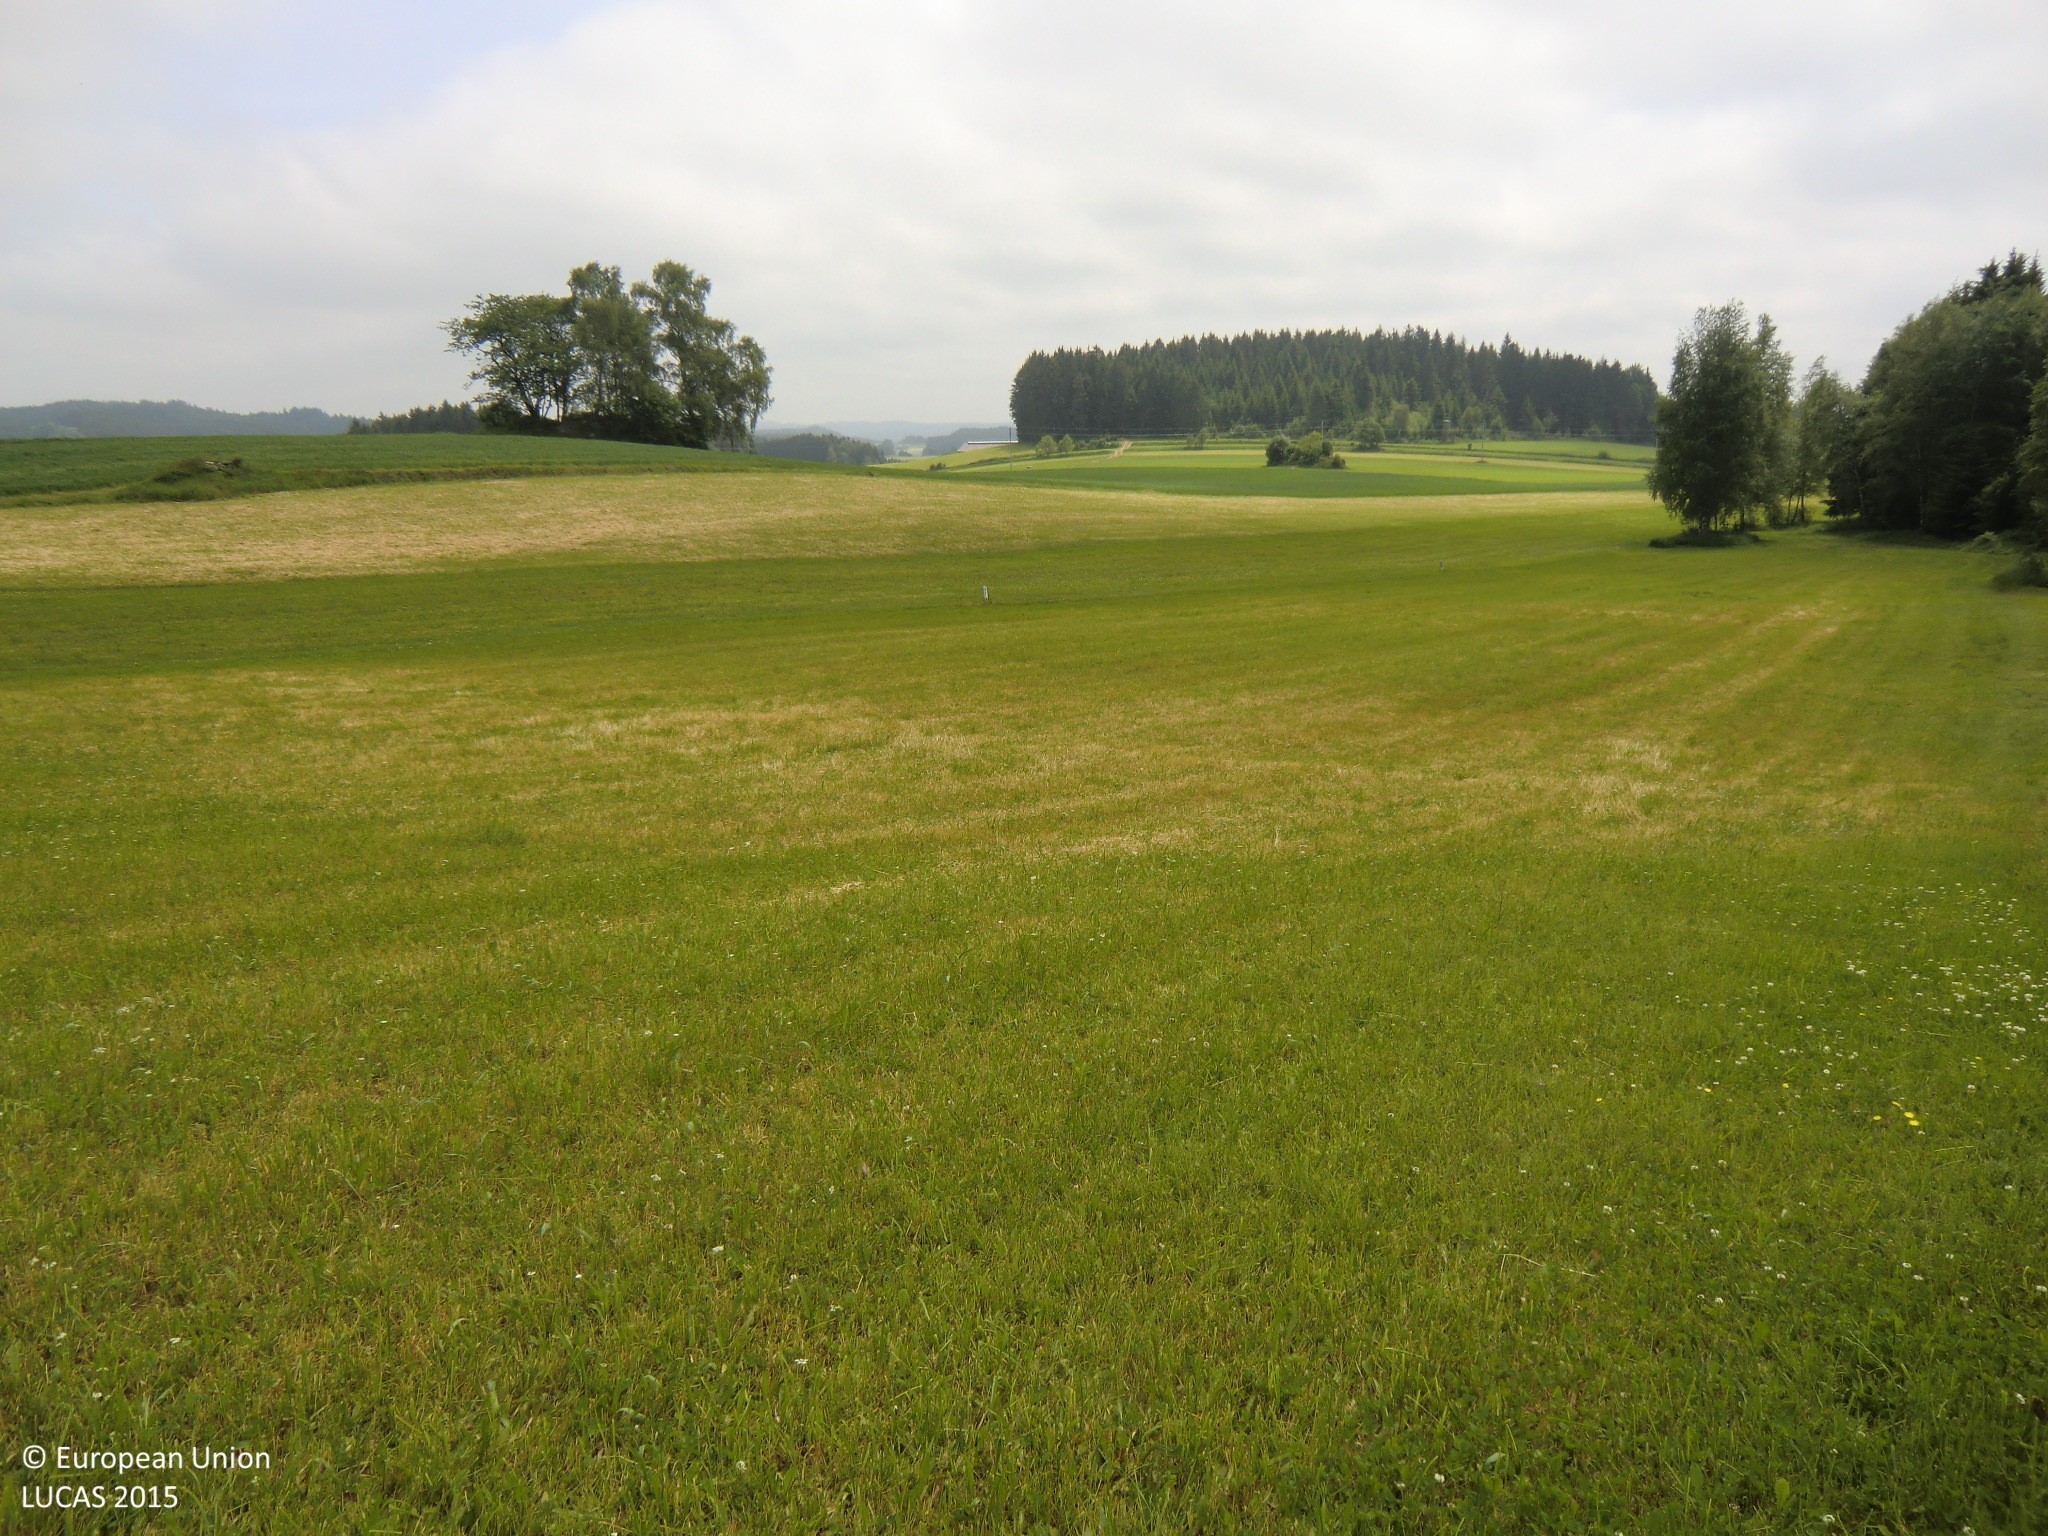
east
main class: Cropland
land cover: Rye
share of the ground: > 75 %
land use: Agriculture (excluding fallow land and kitchen gardens)
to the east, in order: Rye; Grassland without tree/shrub cover; Common wheat; Other leguminous and mixtures for fodder; Tracks
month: June
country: AT
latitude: 48.4423
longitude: 14.8272
